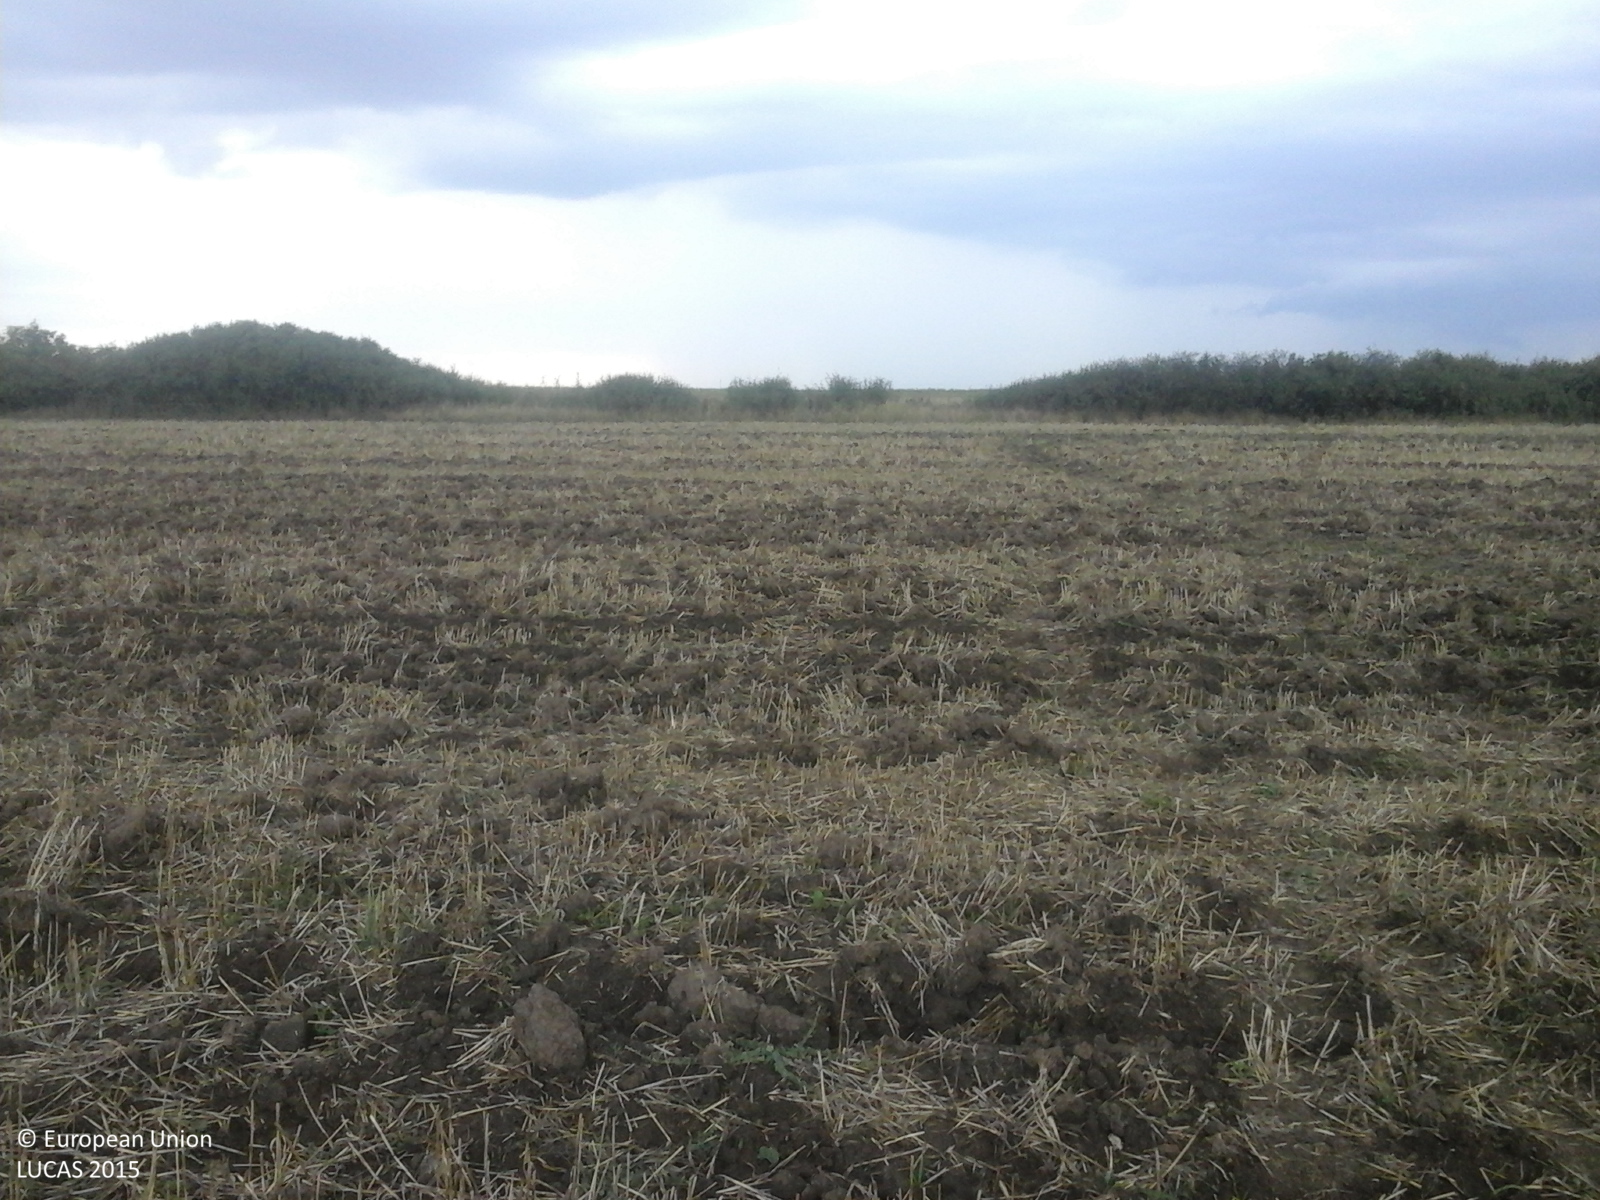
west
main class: Cropland
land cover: Oats
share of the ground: 10 - 25 %
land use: Agriculture (excluding fallow land and kitchen gardens)
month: August
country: RO
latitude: 45.4814
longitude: 21.0939
